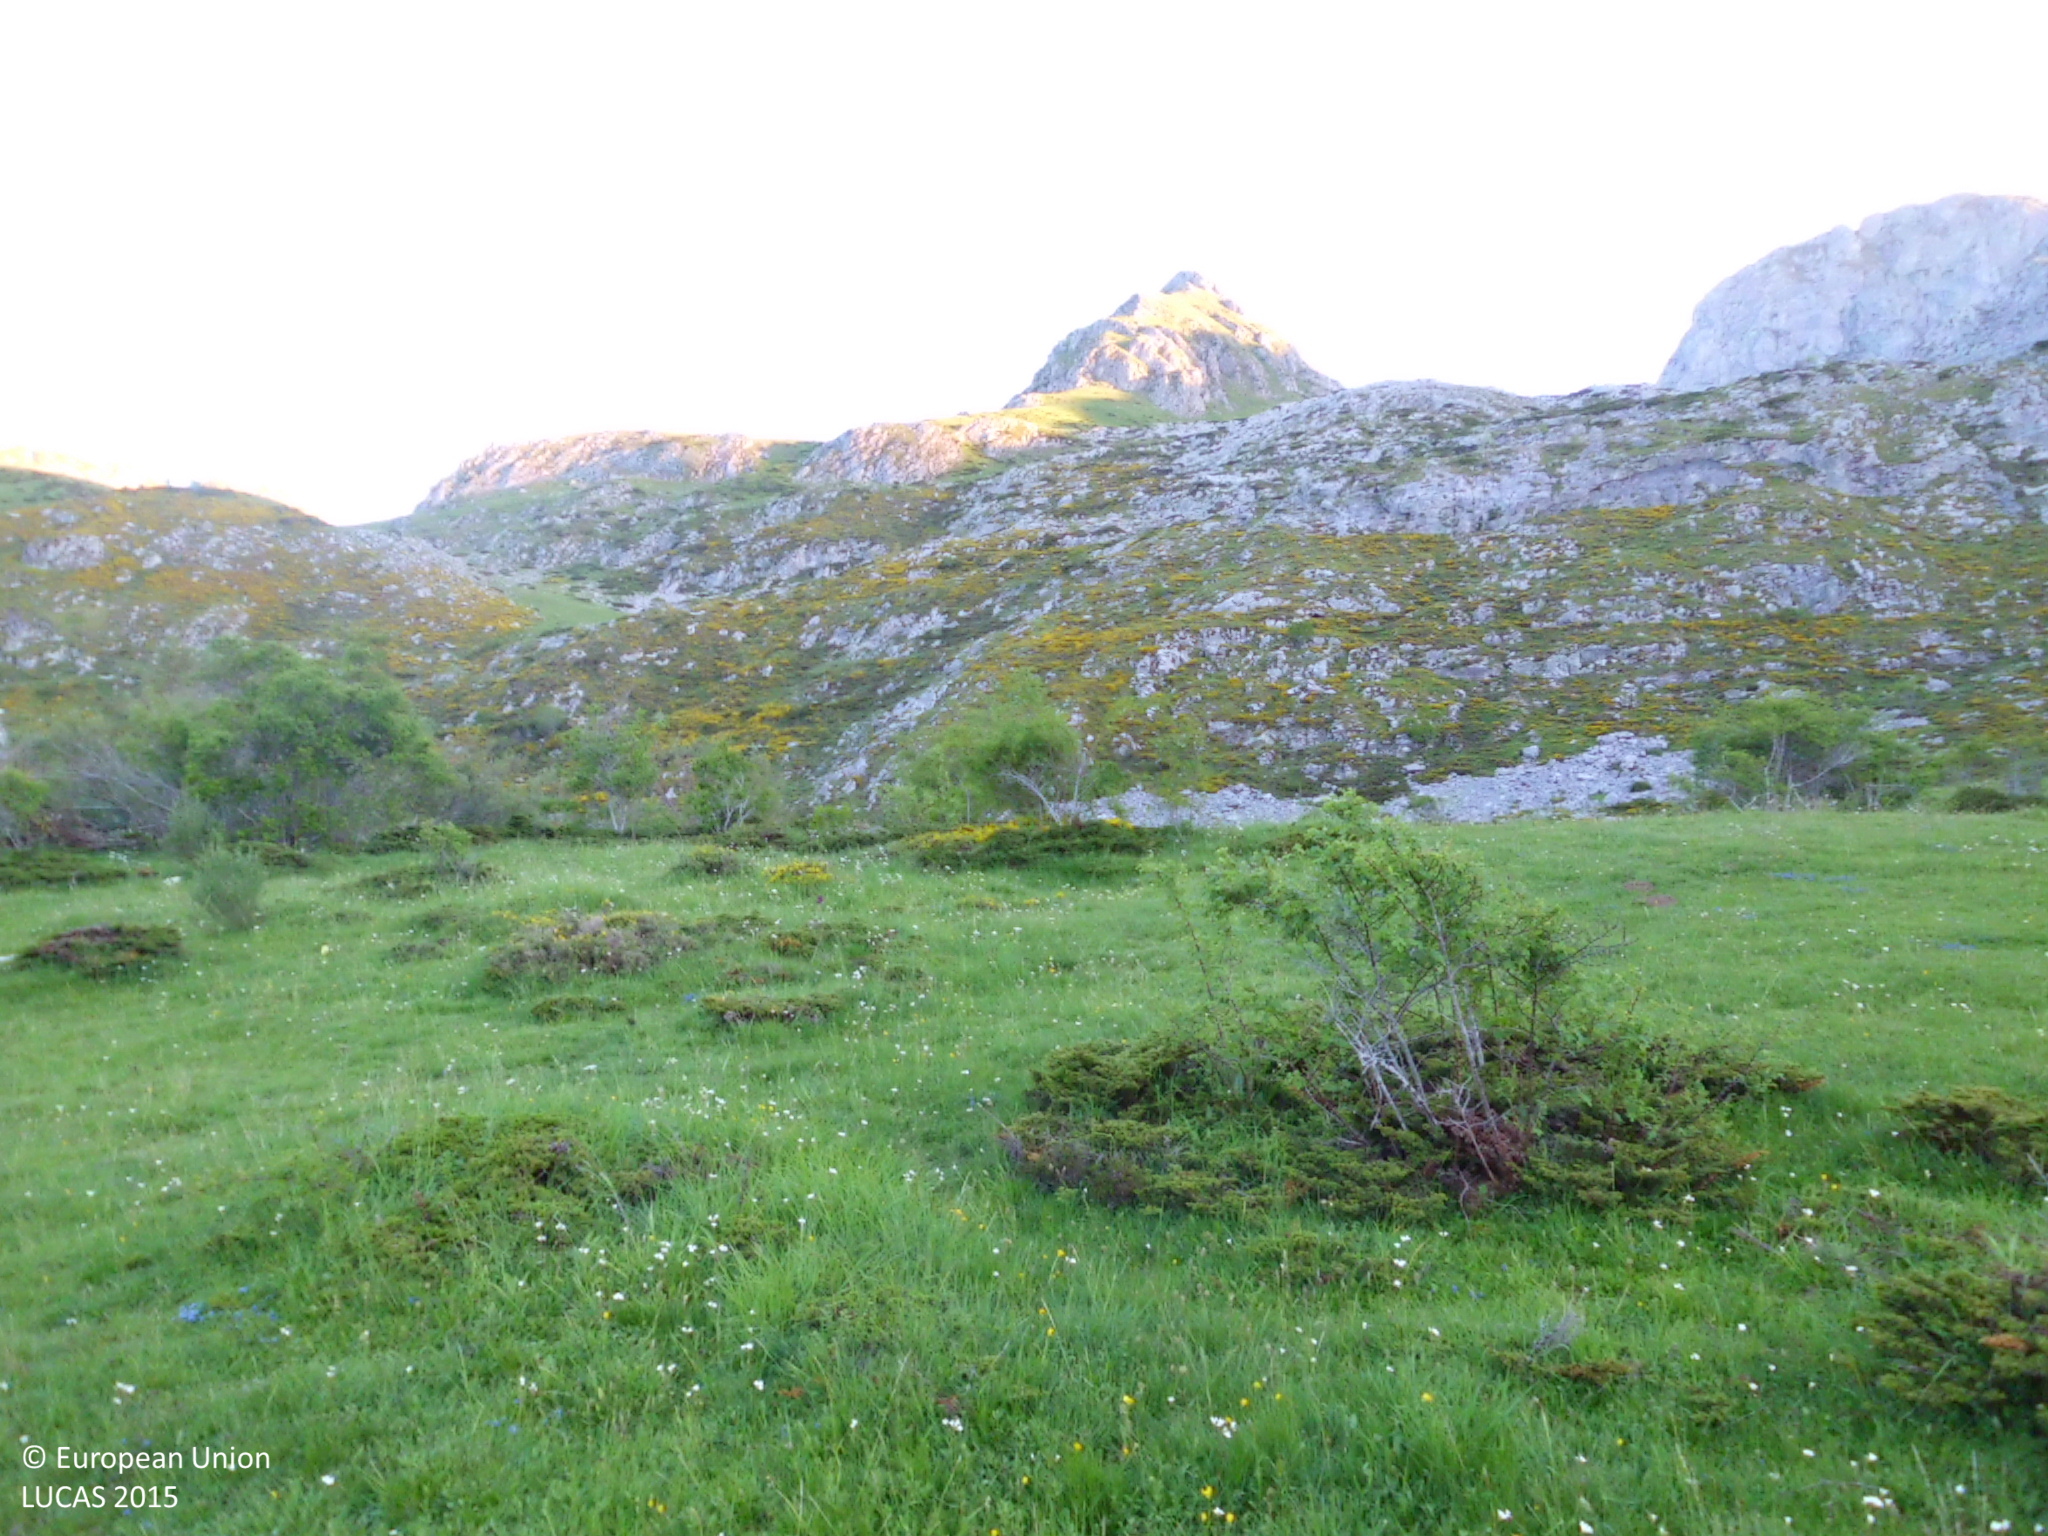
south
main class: Grassland
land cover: Grassland without tree/shrub cover
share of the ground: > 75 %
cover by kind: herbaceous plants 100 %
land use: Agriculture (excluding fallow land and kitchen gardens)
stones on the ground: < 10 %
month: May
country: ES
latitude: 43.0426
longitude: -5.1807
